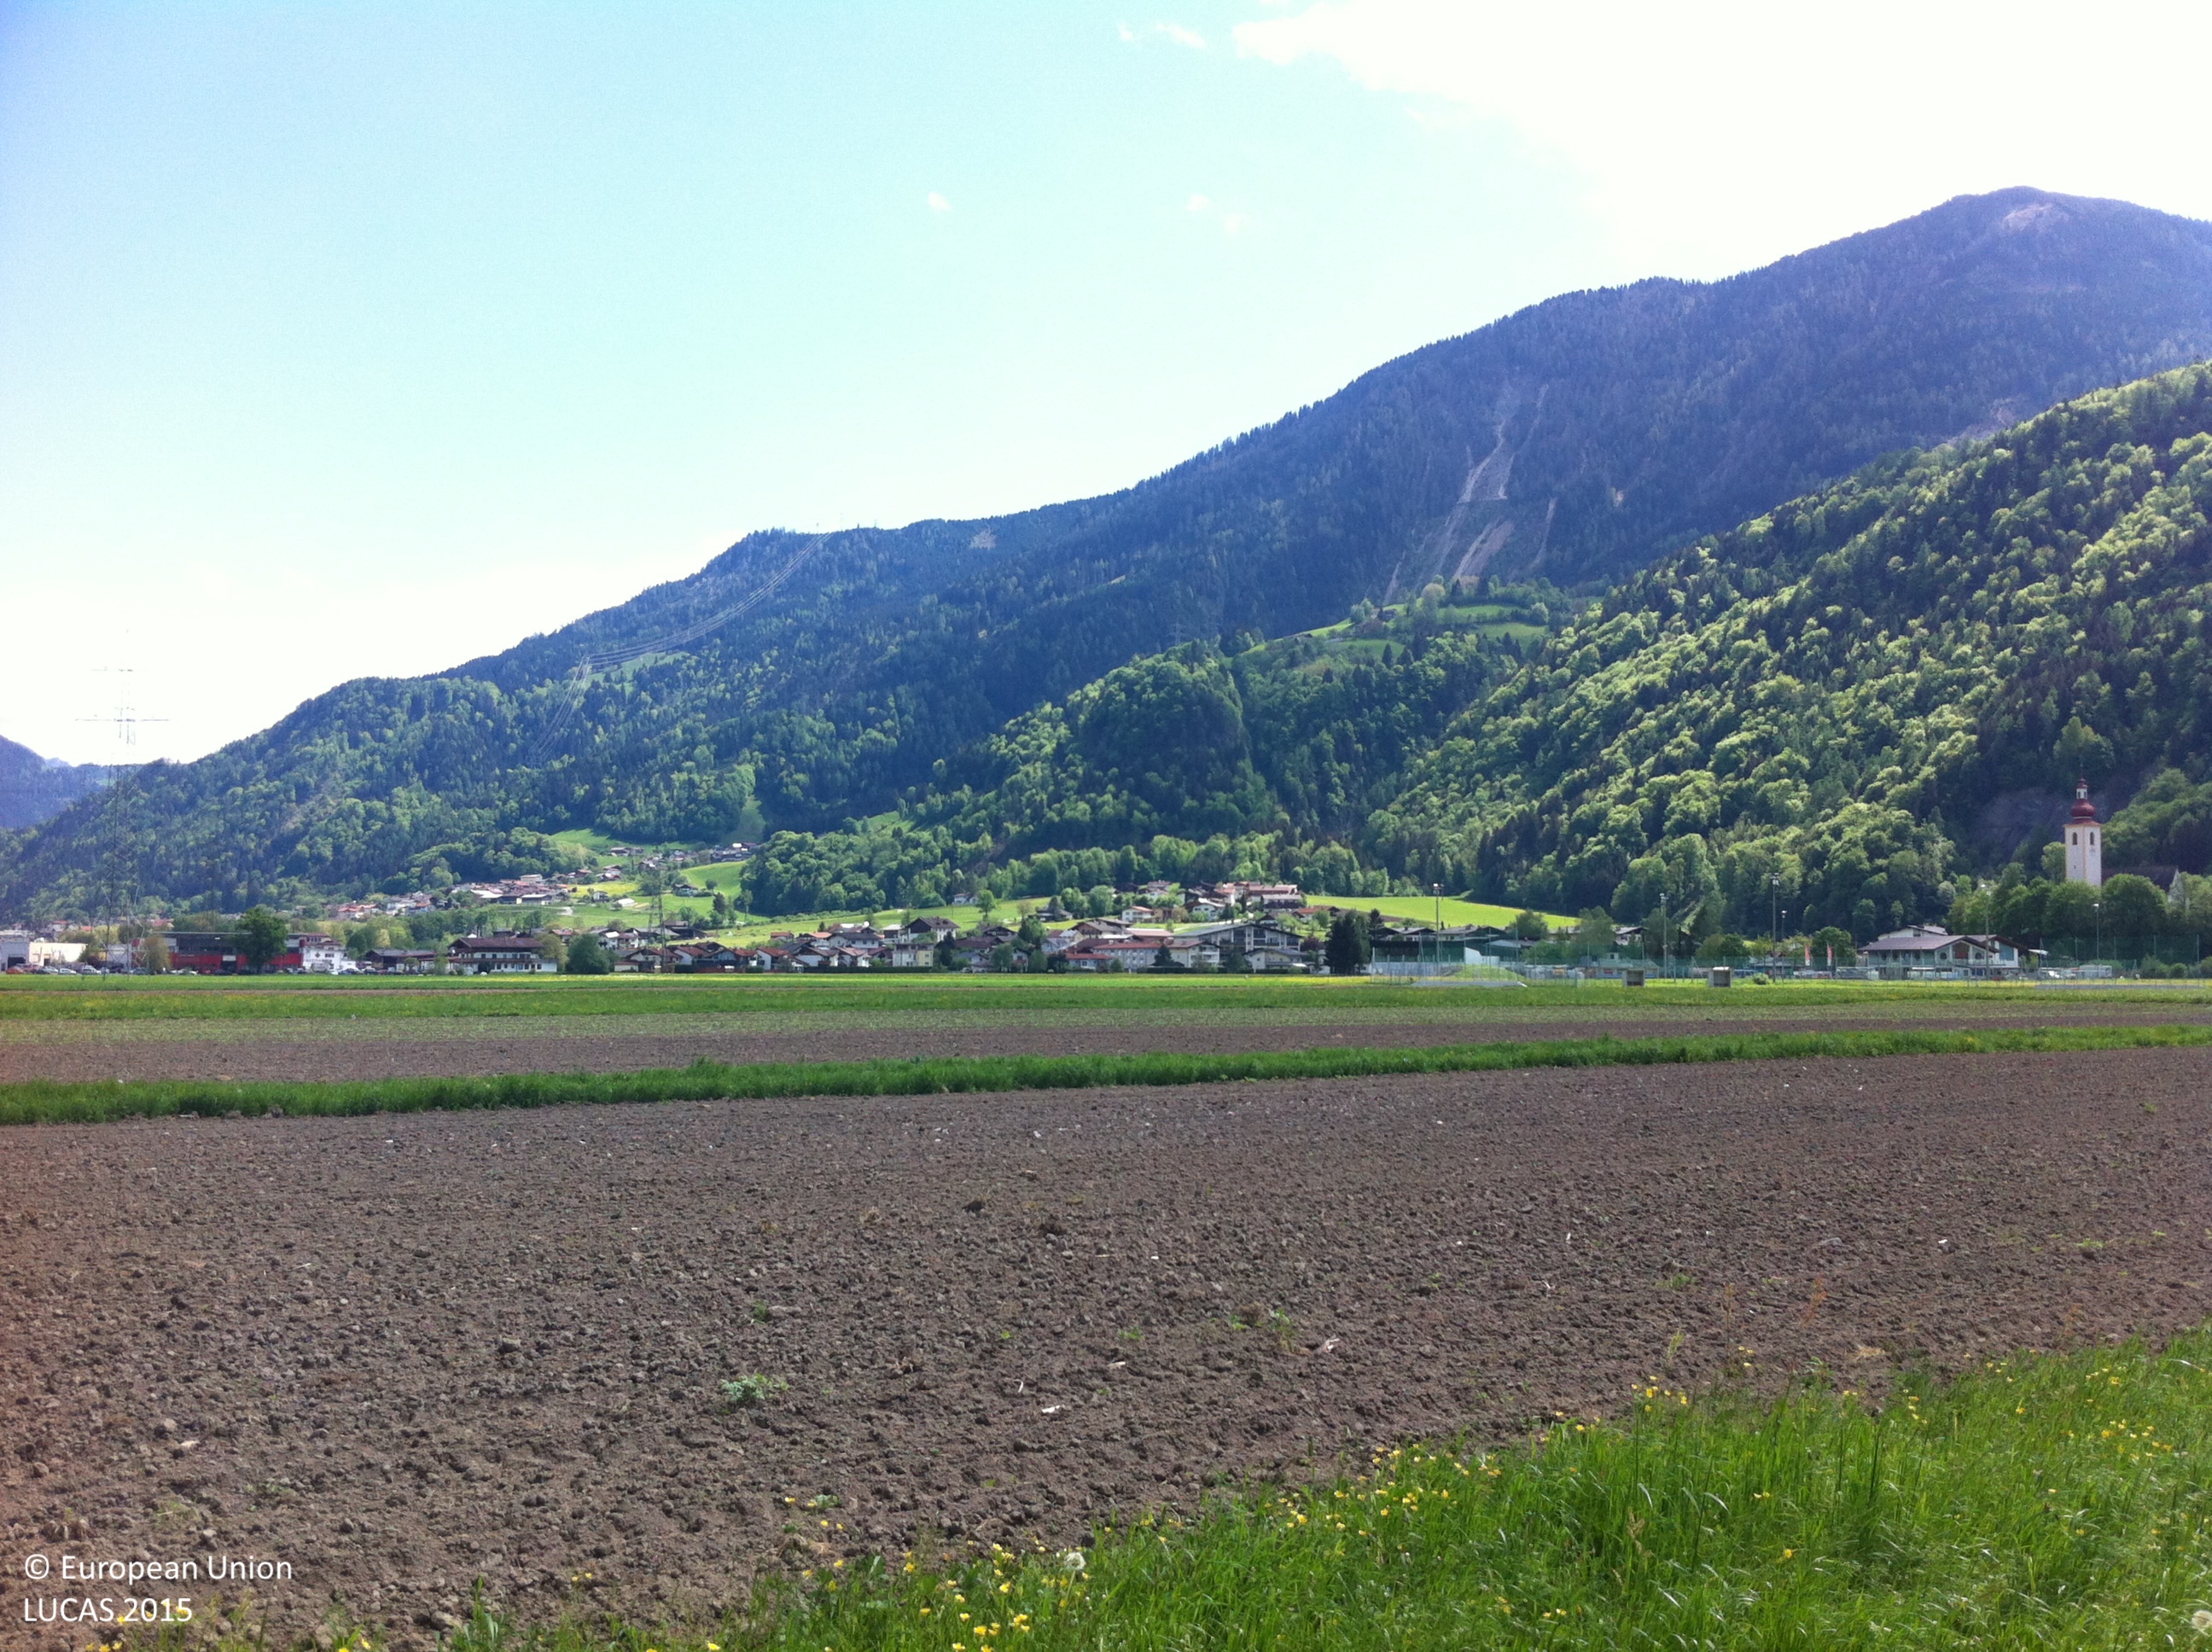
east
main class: Grassland
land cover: Grassland without tree/shrub cover
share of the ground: > 75 %
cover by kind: herbaceous plants 100 %
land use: Agriculture (excluding fallow land and kitchen gardens)
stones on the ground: < 10 %
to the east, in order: Grassland without tree/shrub cover; Maize; Grass margins; Maize; Other fresh vegetables; Tracks; Grassland without tree/shrub cover; Maize
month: May
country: AT
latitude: 47.3814
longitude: 11.7602
